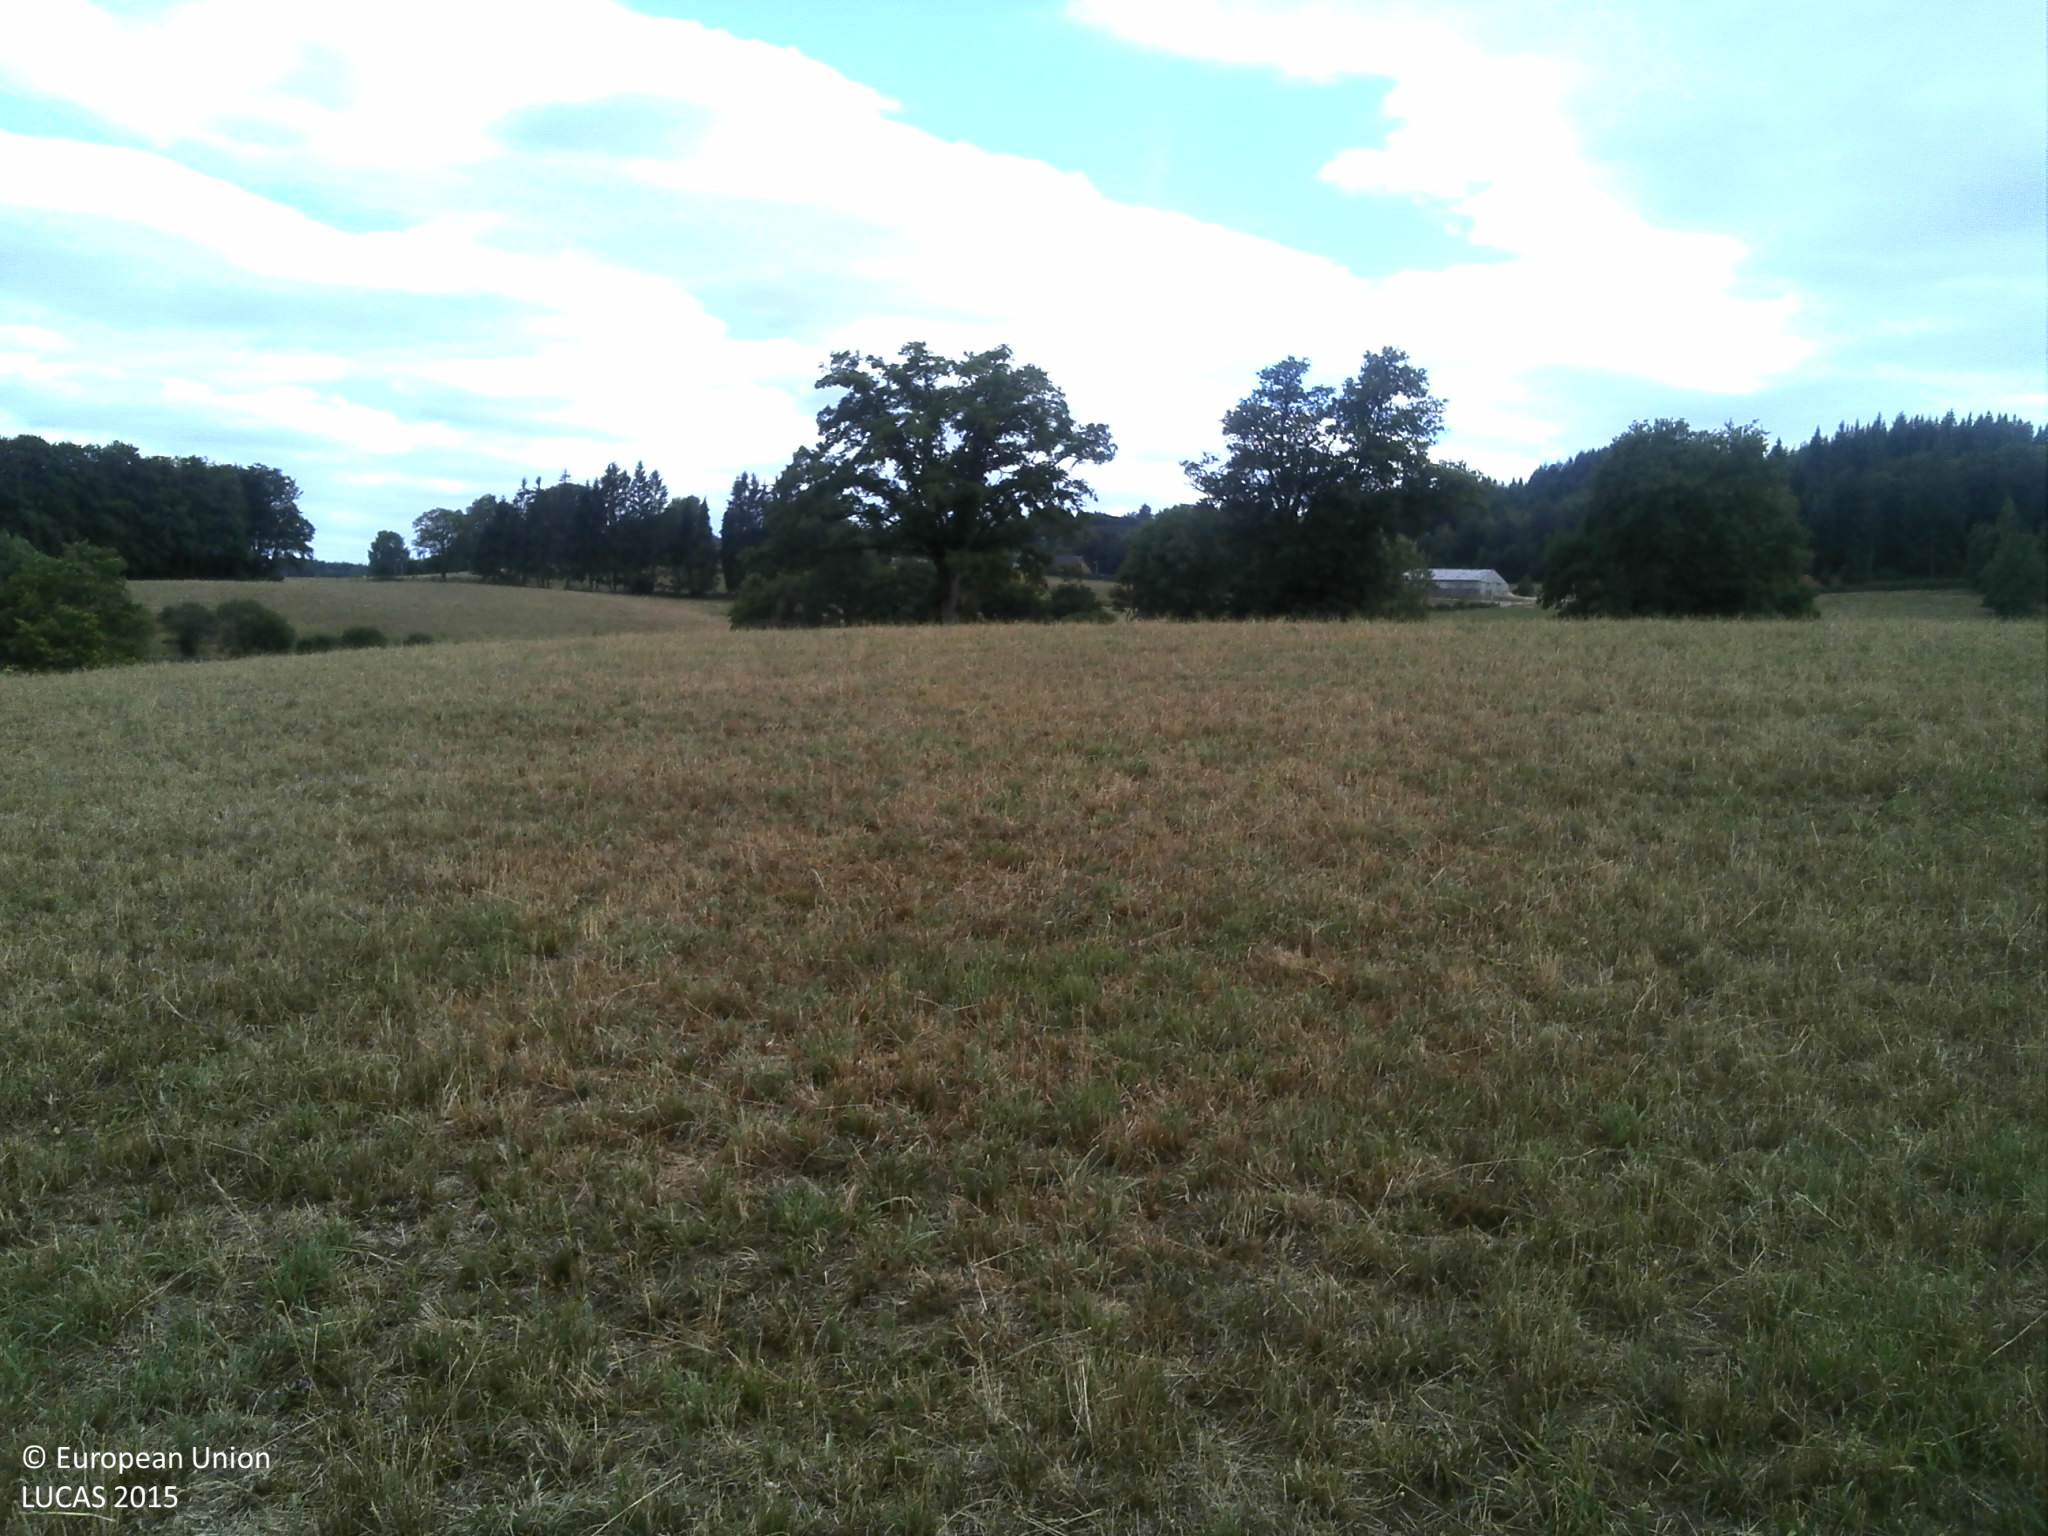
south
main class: Grassland
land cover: Grassland without tree/shrub cover
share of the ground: > 75 %
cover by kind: herbaceous plants 100 %
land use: Agriculture (excluding fallow land and kitchen gardens)
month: July
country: FR
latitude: 45.6277
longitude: 2.3914
